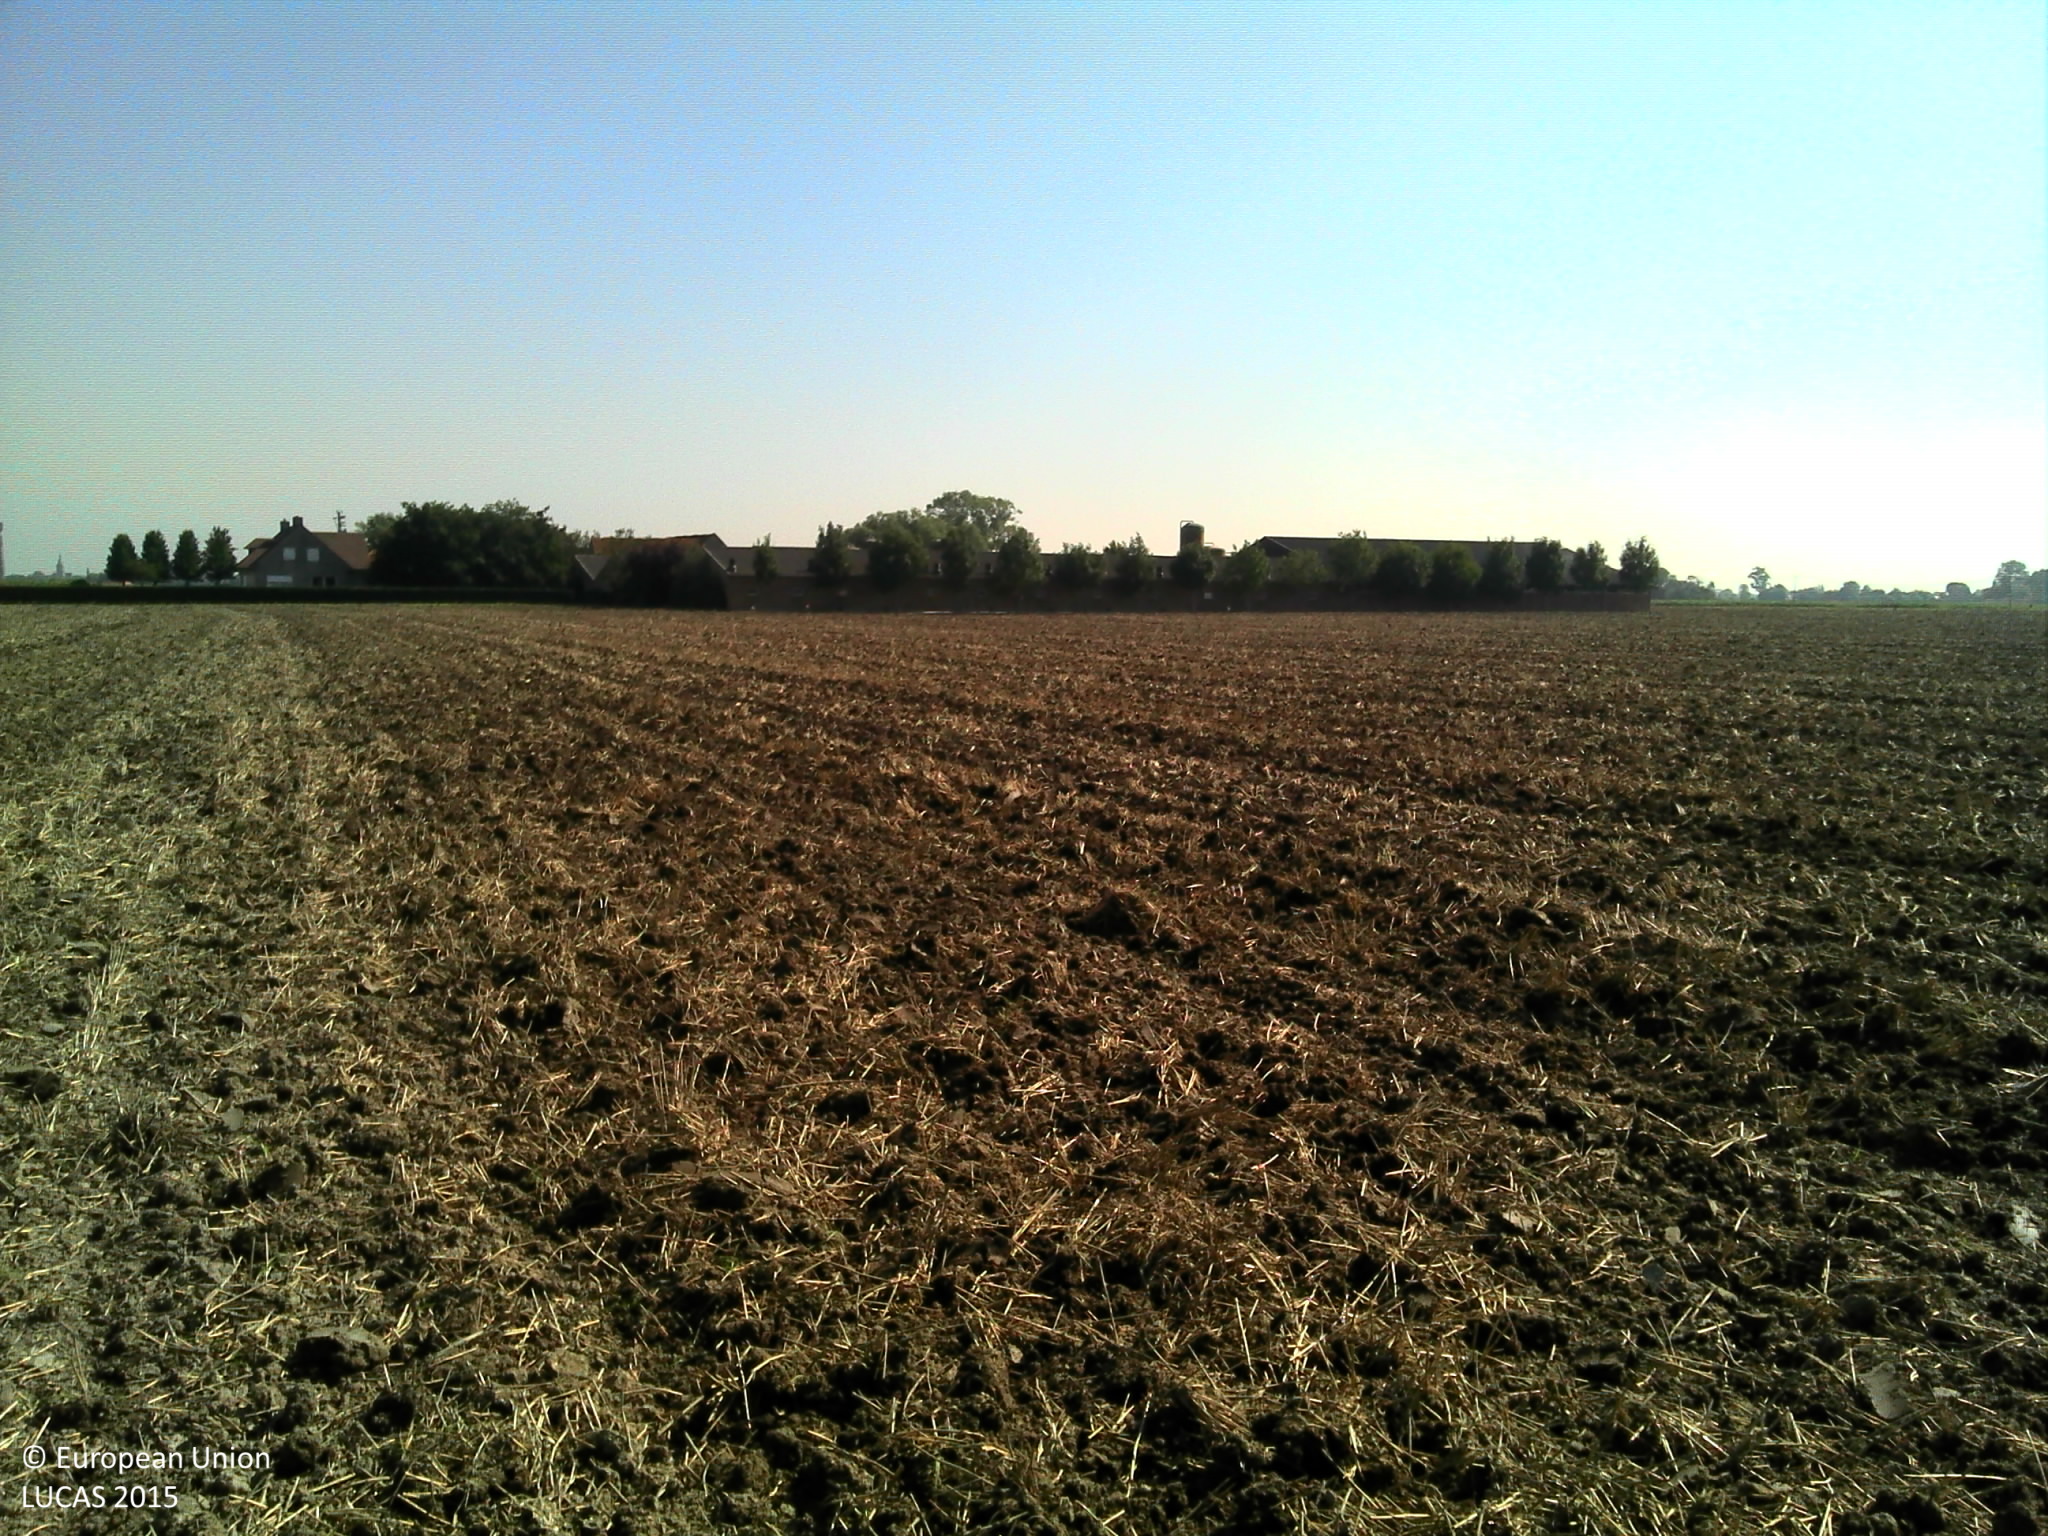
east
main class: Cropland
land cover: Common wheat
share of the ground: 50 - 75 %
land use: Agriculture (excluding fallow land and kitchen gardens)
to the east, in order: Common wheat; Lines of trees; Artificial constructions in urban areas
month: September
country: BE
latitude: 51.0227
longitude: 2.8178
